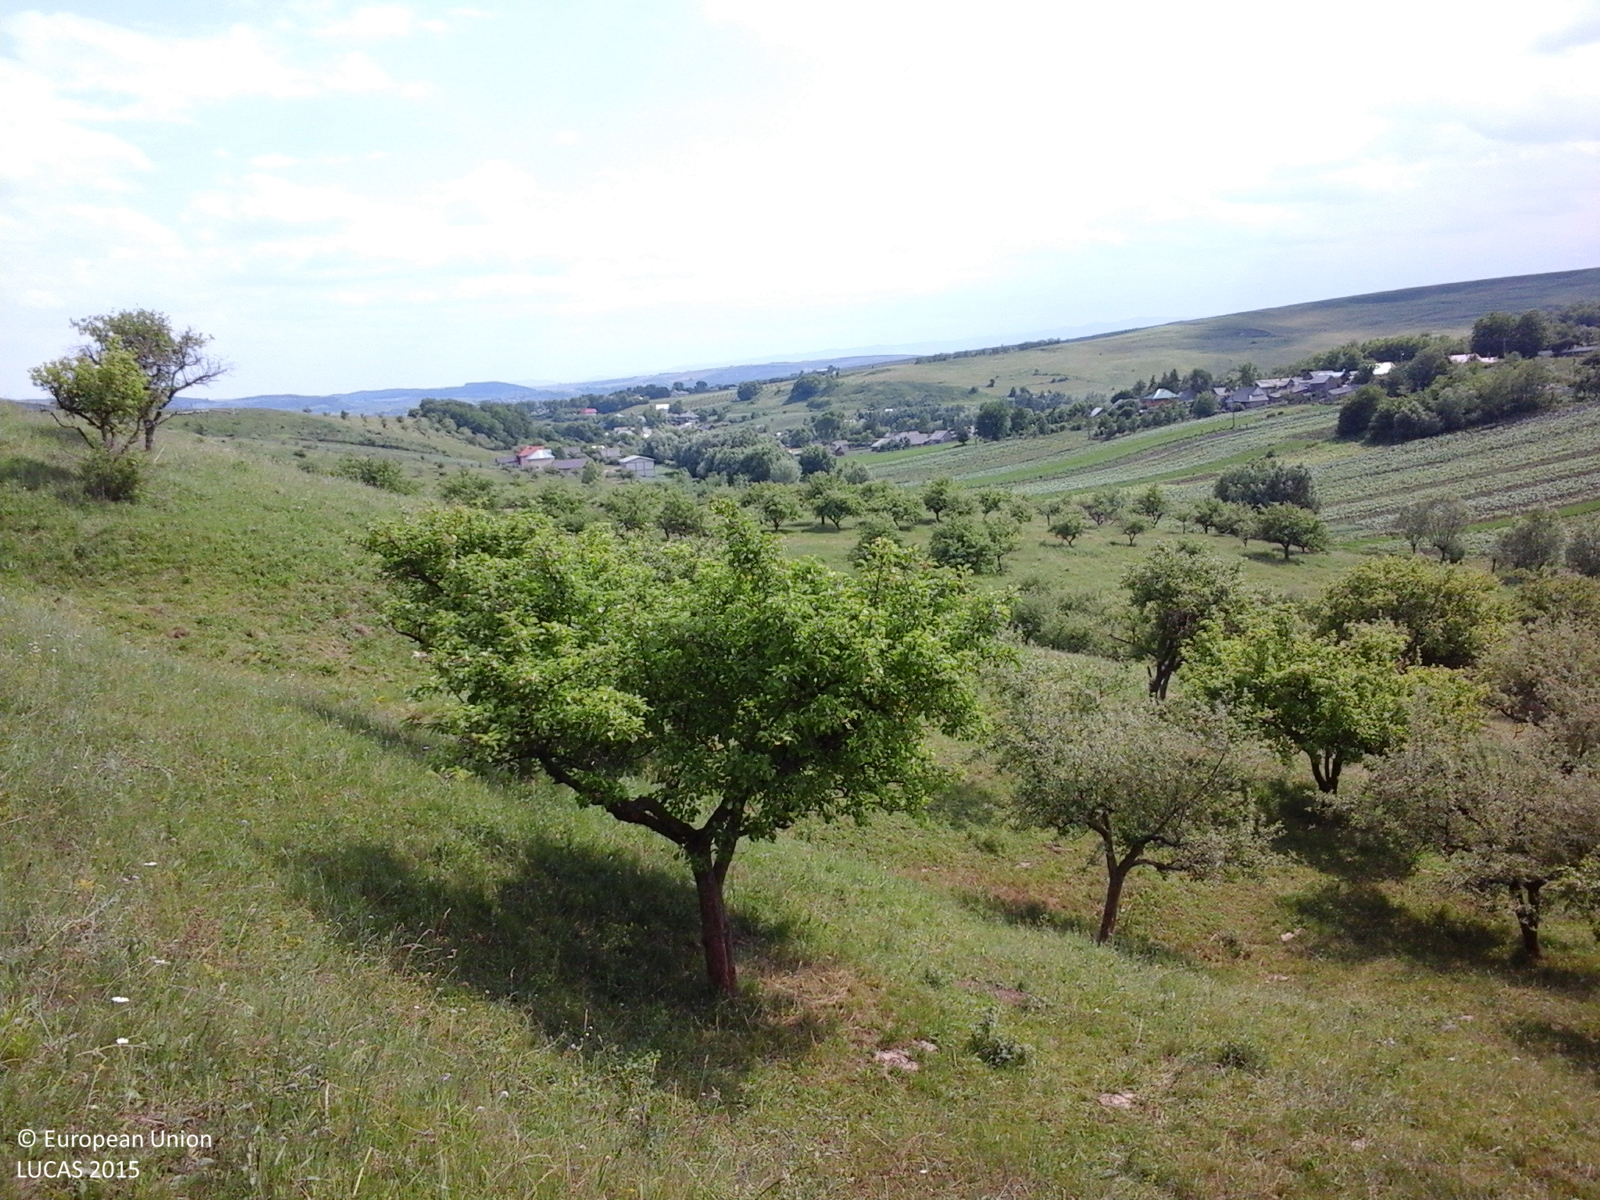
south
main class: Cropland
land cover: Apple fruit
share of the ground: 25 - 50 %
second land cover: Grassland without tree/shrub cover
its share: > 75 %
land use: Agriculture (excluding fallow land and kitchen gardens)
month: June
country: RO
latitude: 47.5100
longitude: 26.3228
